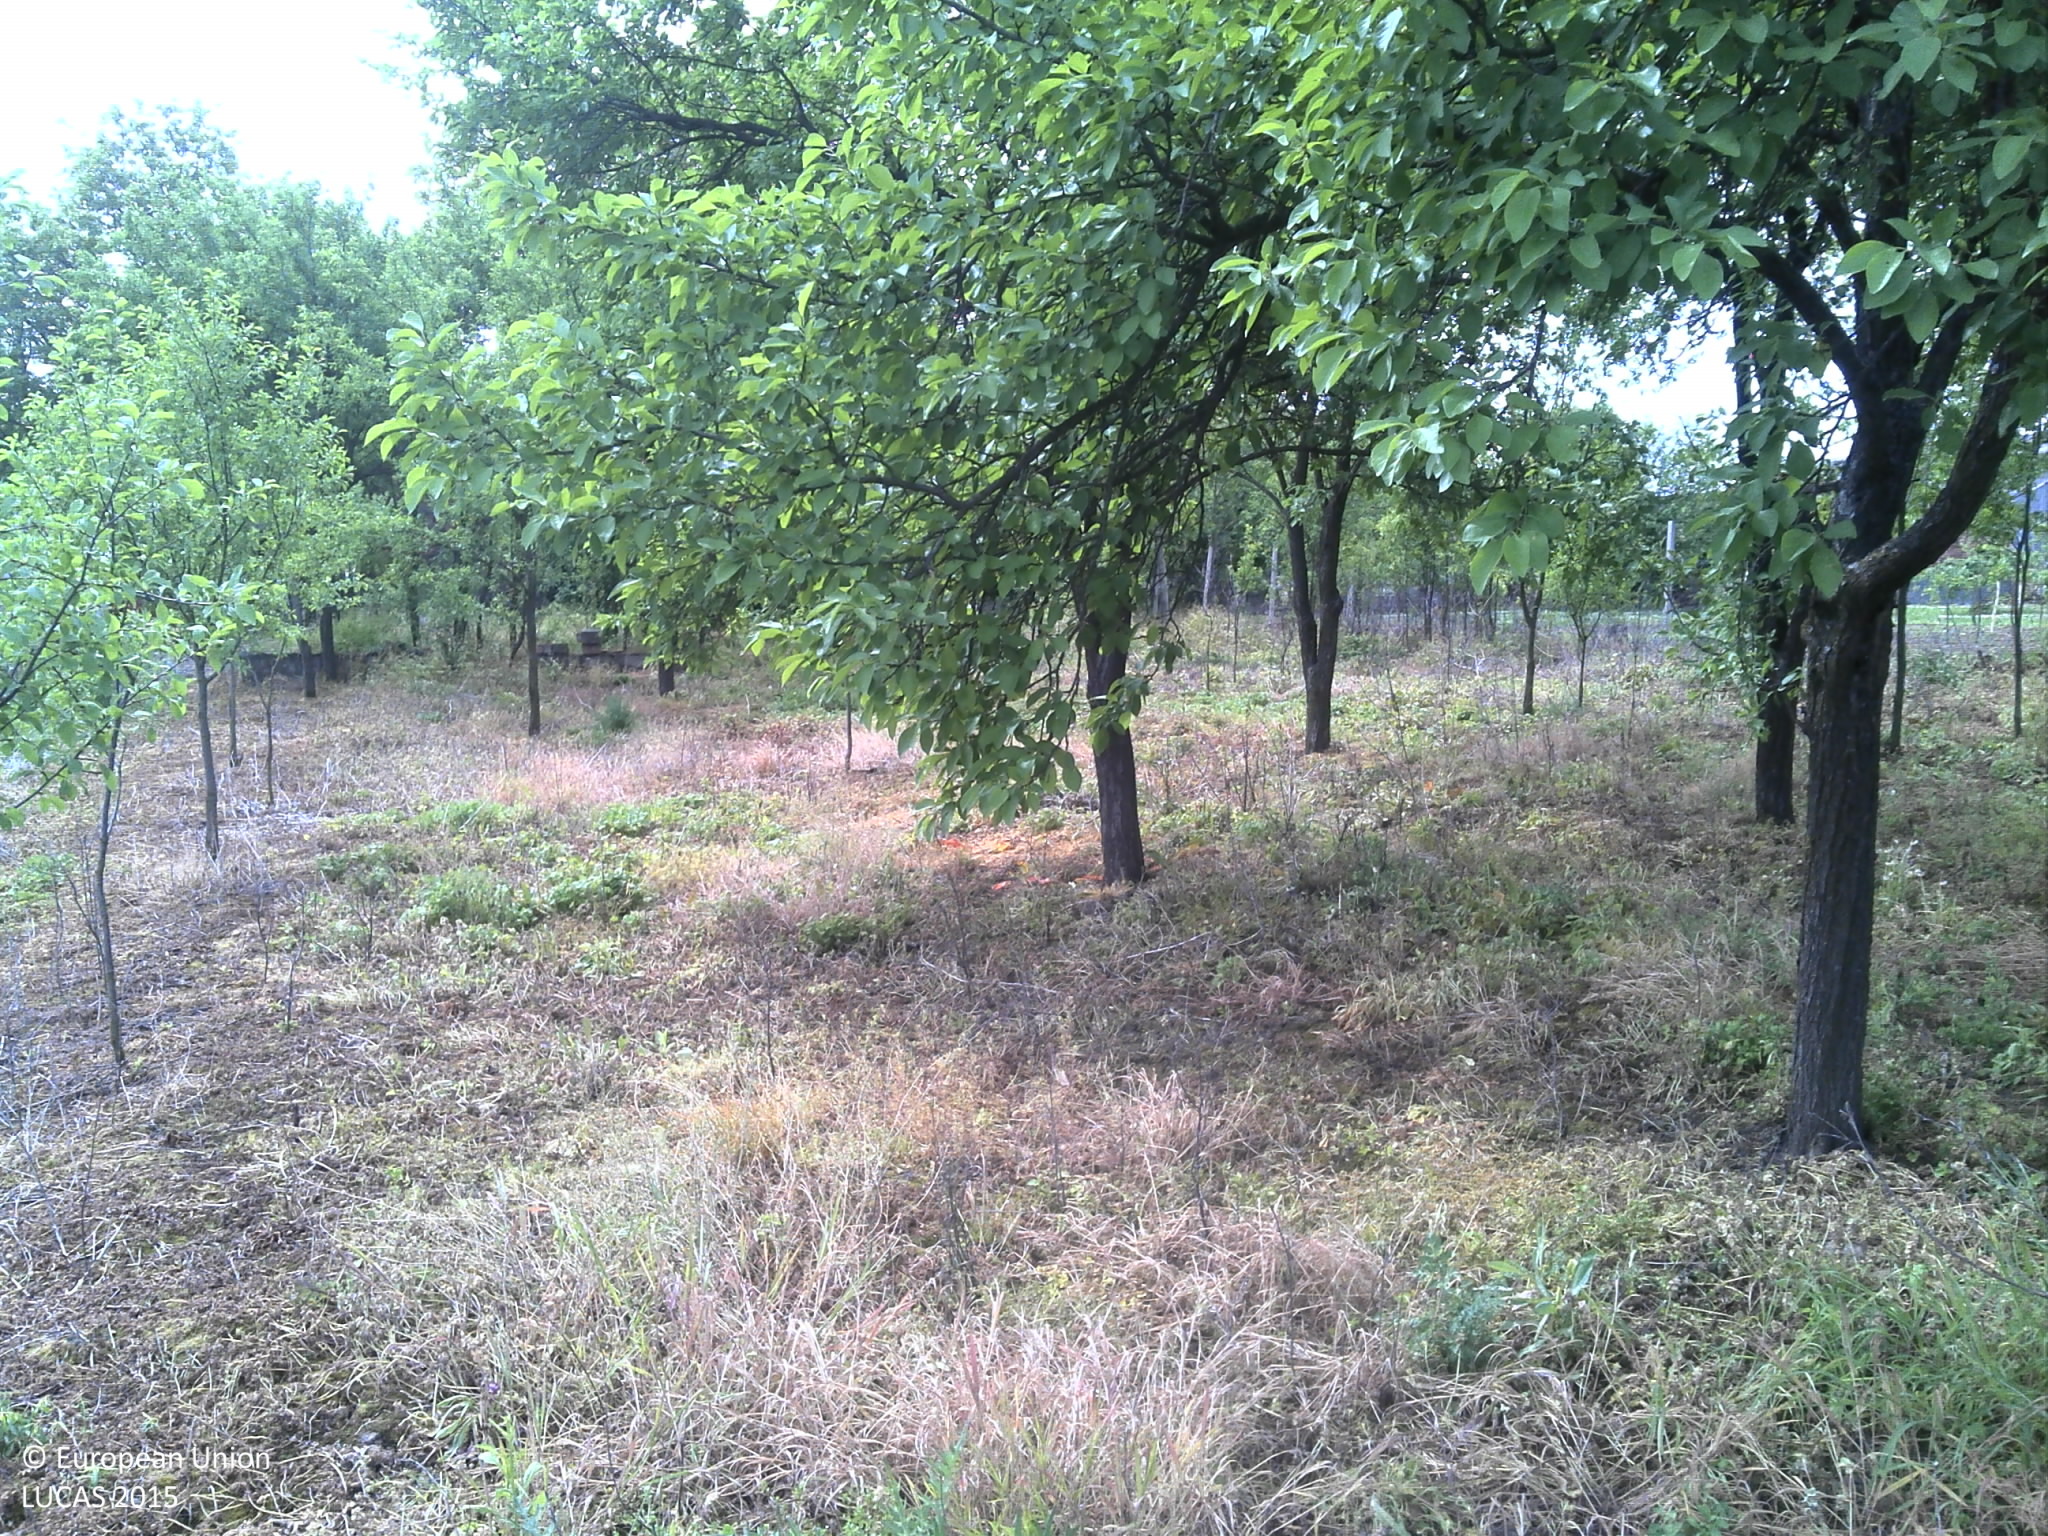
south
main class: Cropland
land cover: Other fruit trees and berries
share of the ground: > 75 %
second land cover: Spontaneously vegetated surfaces
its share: > 75 %
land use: Agriculture (excluding fallow land and kitchen gardens)
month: May
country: HR
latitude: 45.2383
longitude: 19.0916
